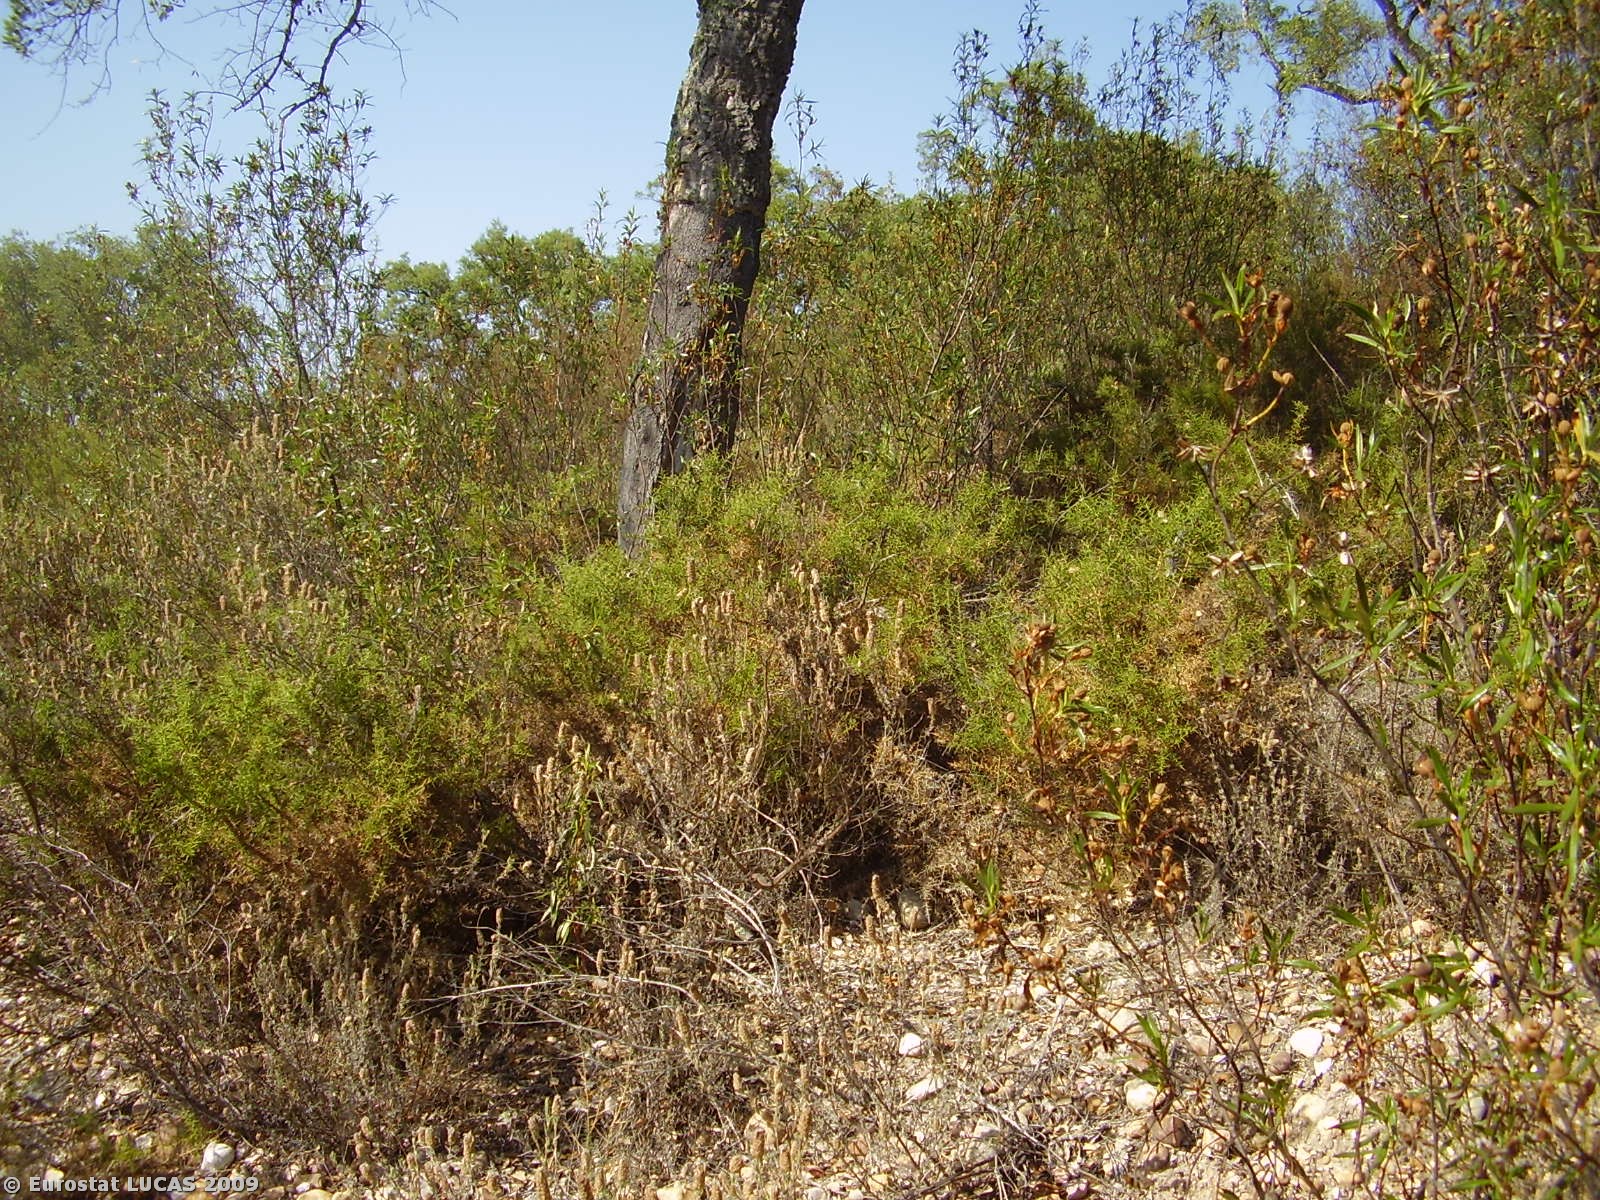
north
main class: Woodland
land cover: Broadleaved woodland
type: broadleaved evergreen forest
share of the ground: 10 - 25 %
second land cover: Shrubland with sparse tree cover
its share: > 75 %
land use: Forestry
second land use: Fallow land
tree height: > 5 m
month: July
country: PT
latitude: 39.4095
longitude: -8.0488
